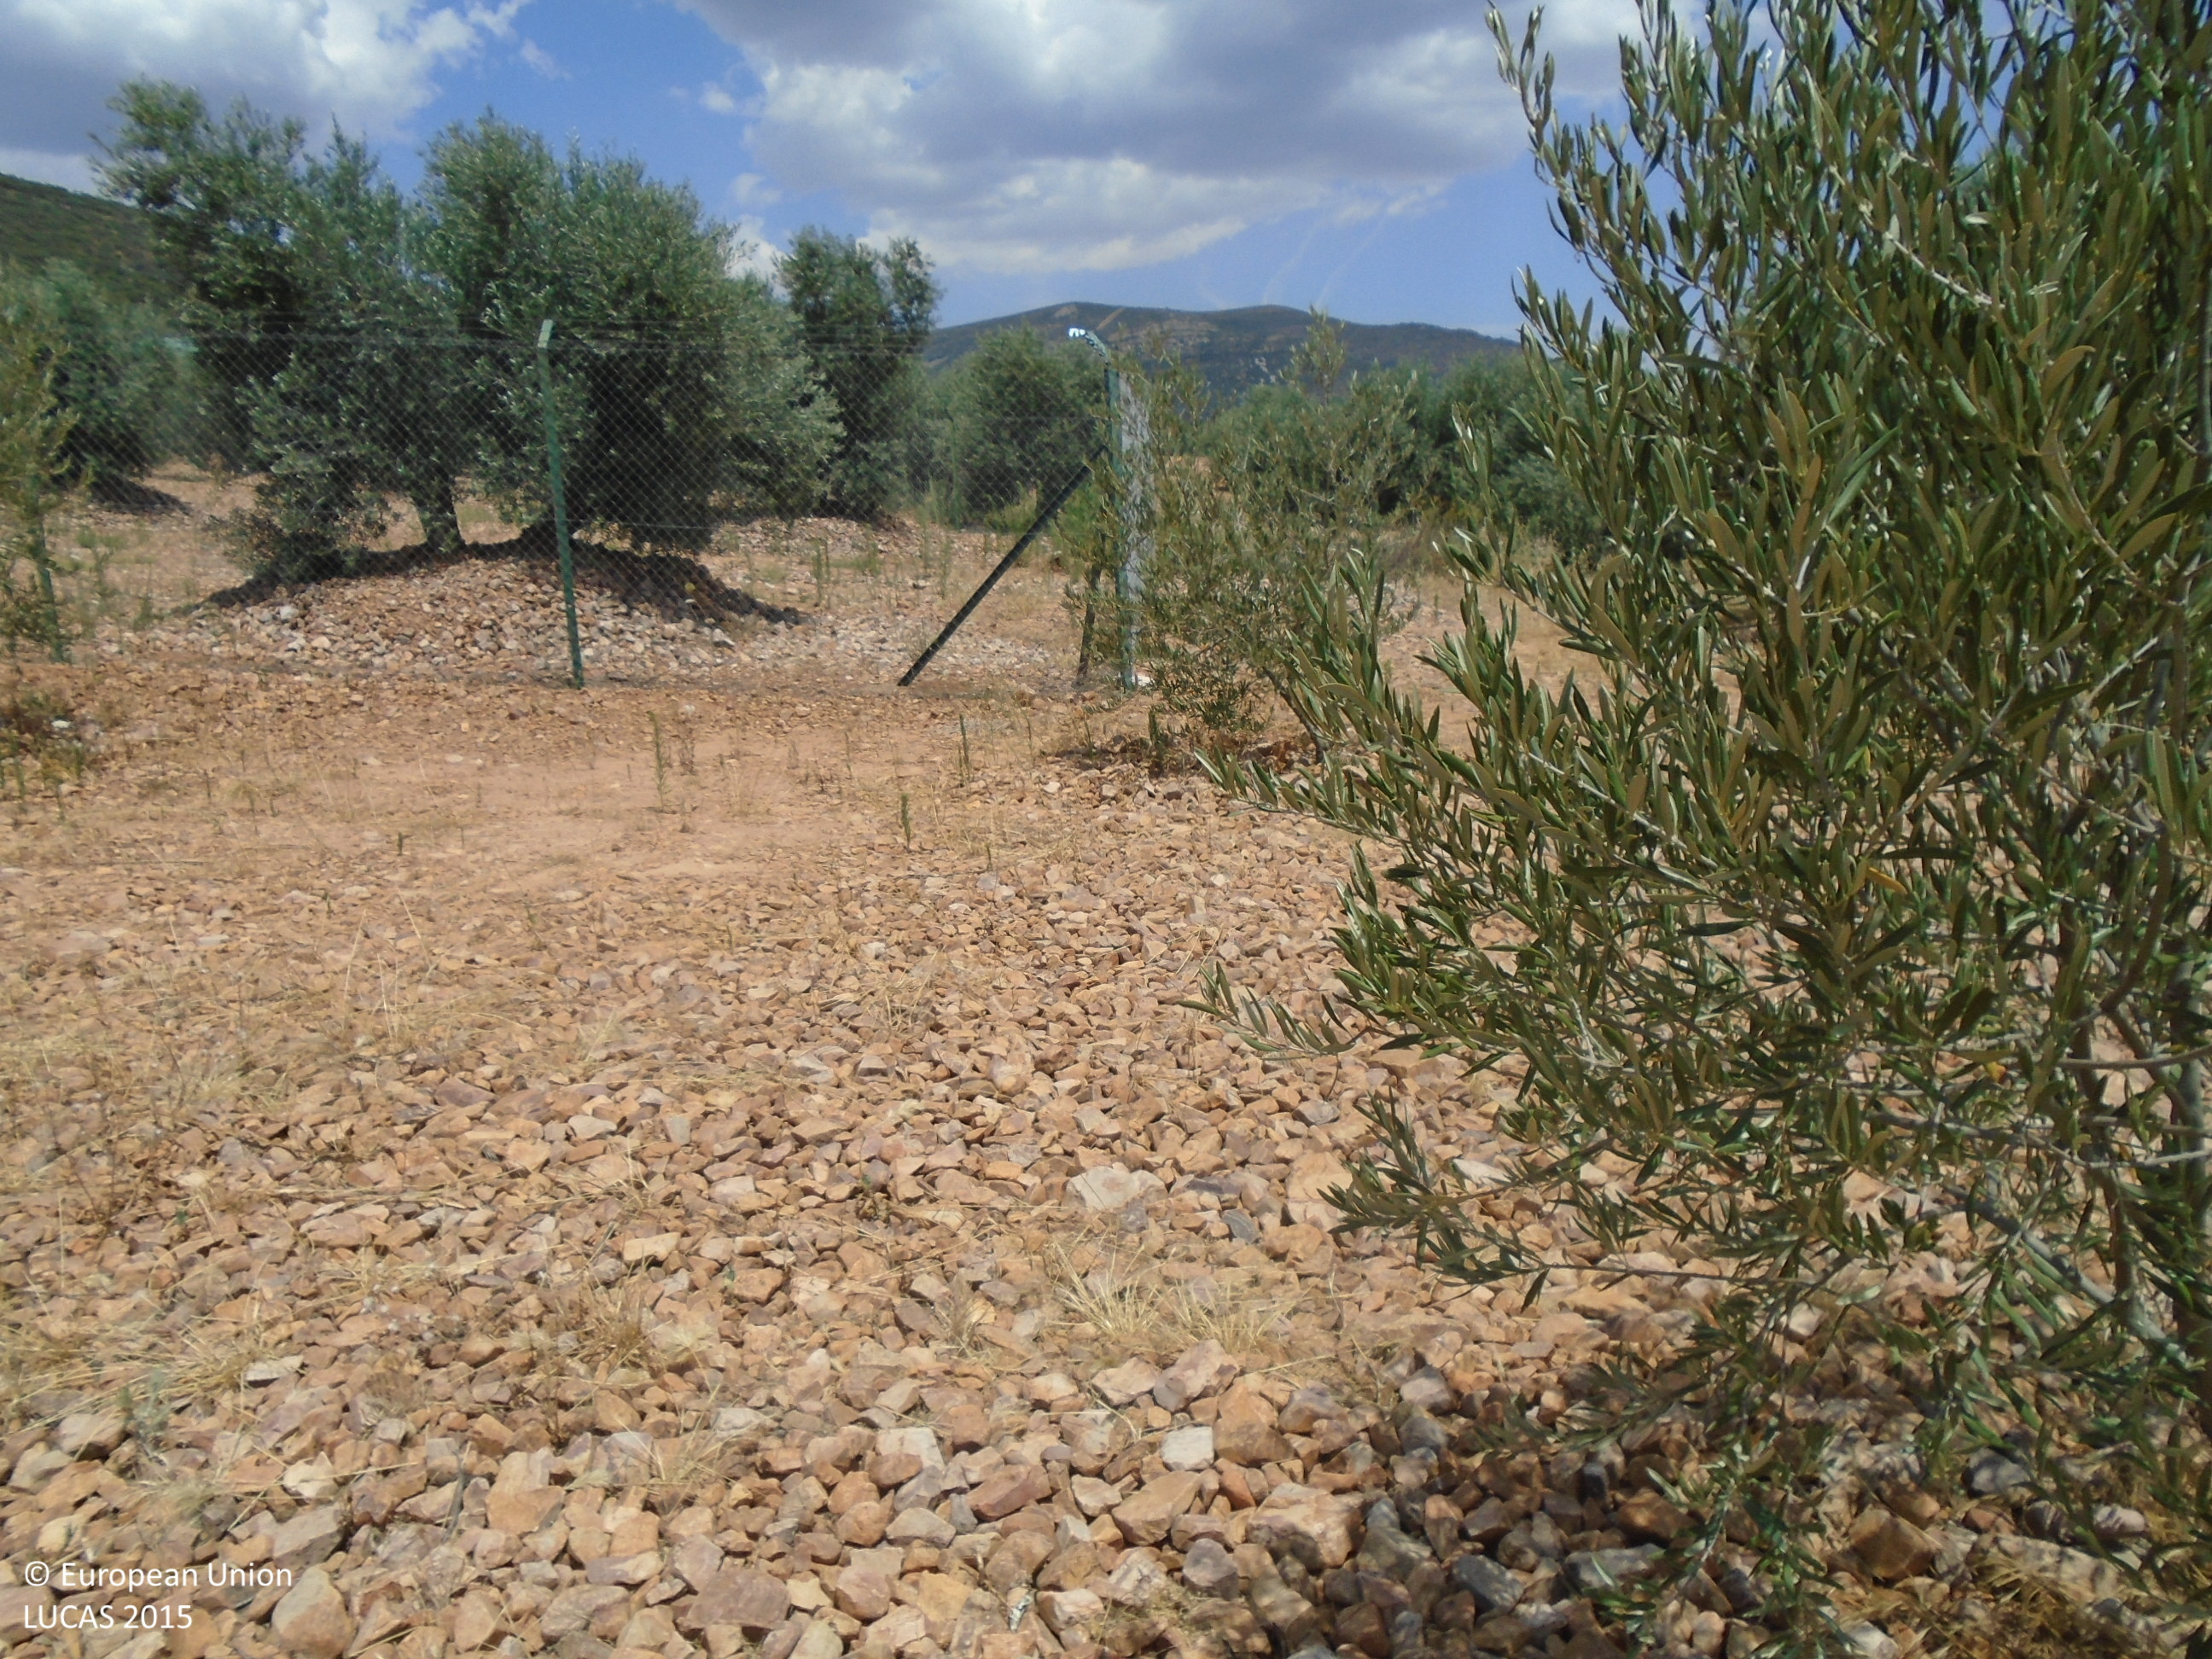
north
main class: Cropland
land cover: Olive groves
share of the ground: 10 - 25 %
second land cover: Other bare soil
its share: > 75 %
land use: Agriculture (excluding fallow land and kitchen gardens)
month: June
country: ES
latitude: 39.2406
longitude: -3.6108
